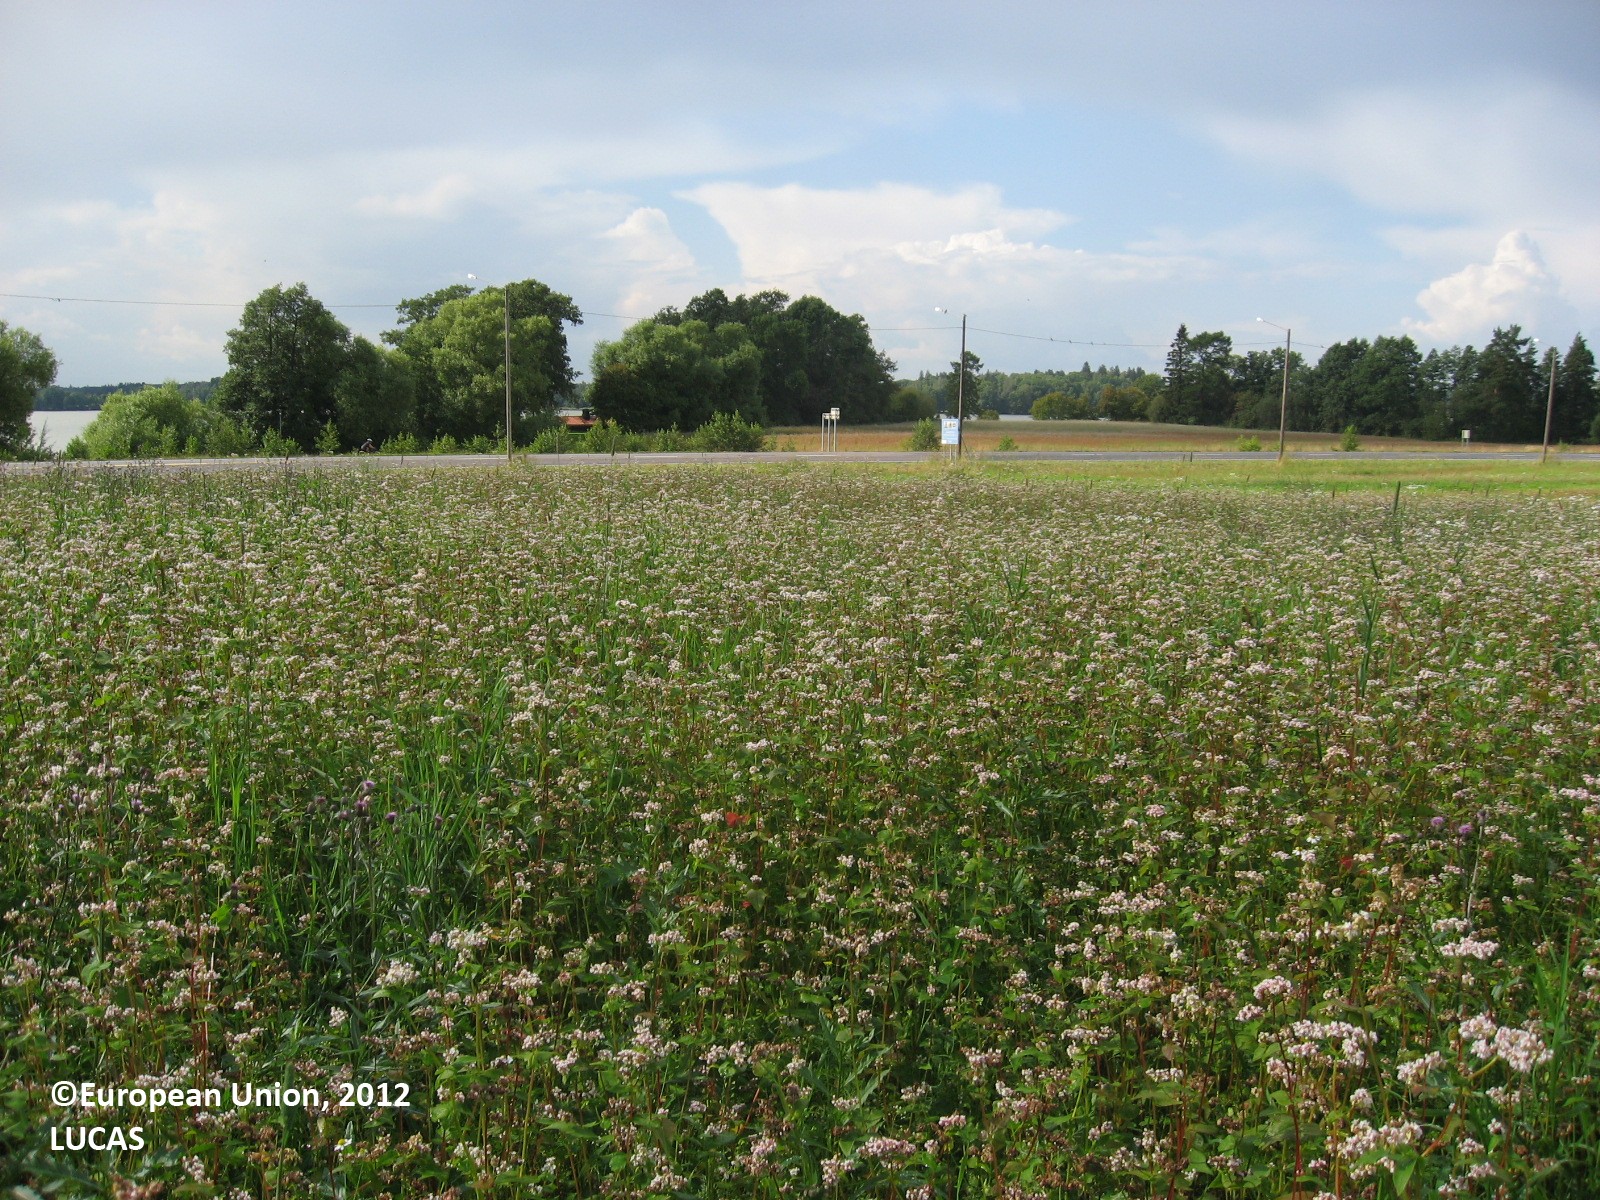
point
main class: Cropland
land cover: Other cereals
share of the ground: > 75 %
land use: Agriculture (excluding fallow land and kitchen gardens)
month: August
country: FI
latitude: 60.4477
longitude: 25.0787
